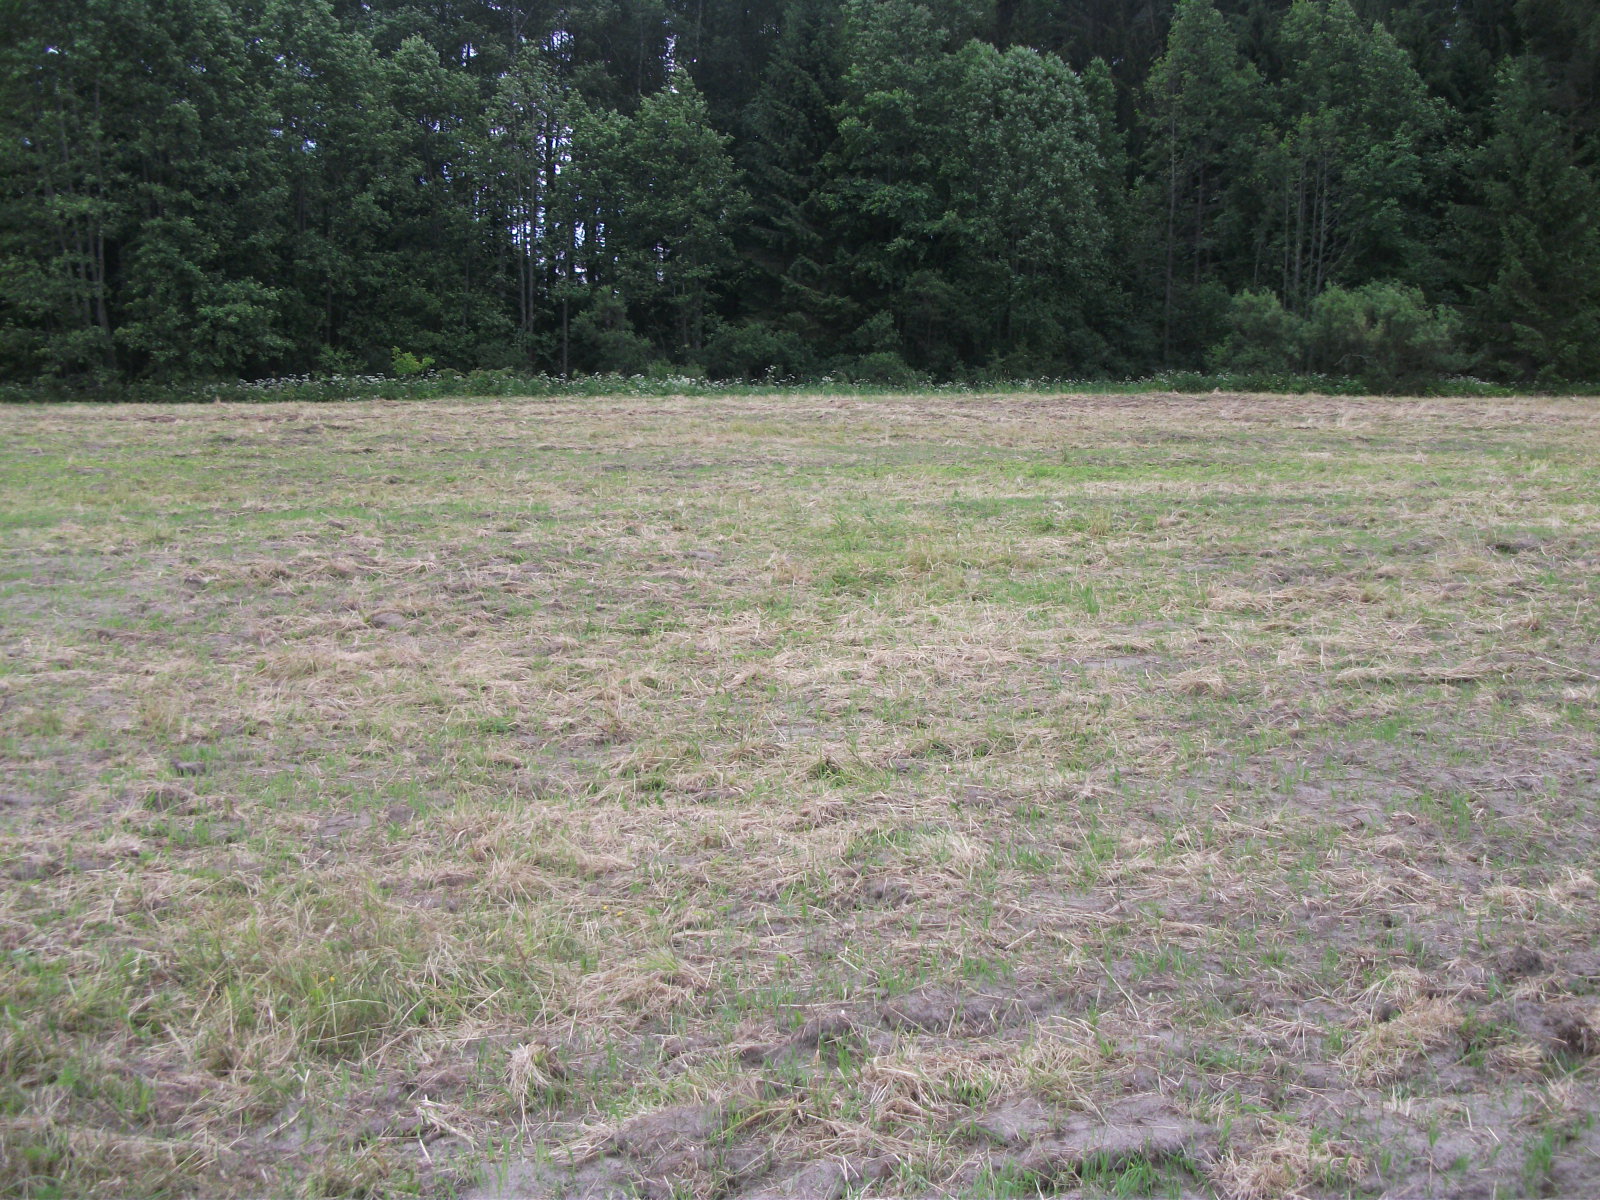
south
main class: Grassland
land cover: Grassland without tree/shrub cover
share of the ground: 50 - 75 %
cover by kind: herbaceous plants 70 %, unconsolidated bare surface 30 %
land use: Agriculture (excluding fallow land and kitchen gardens)
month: January
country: LV
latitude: 56.8890
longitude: 26.6800
